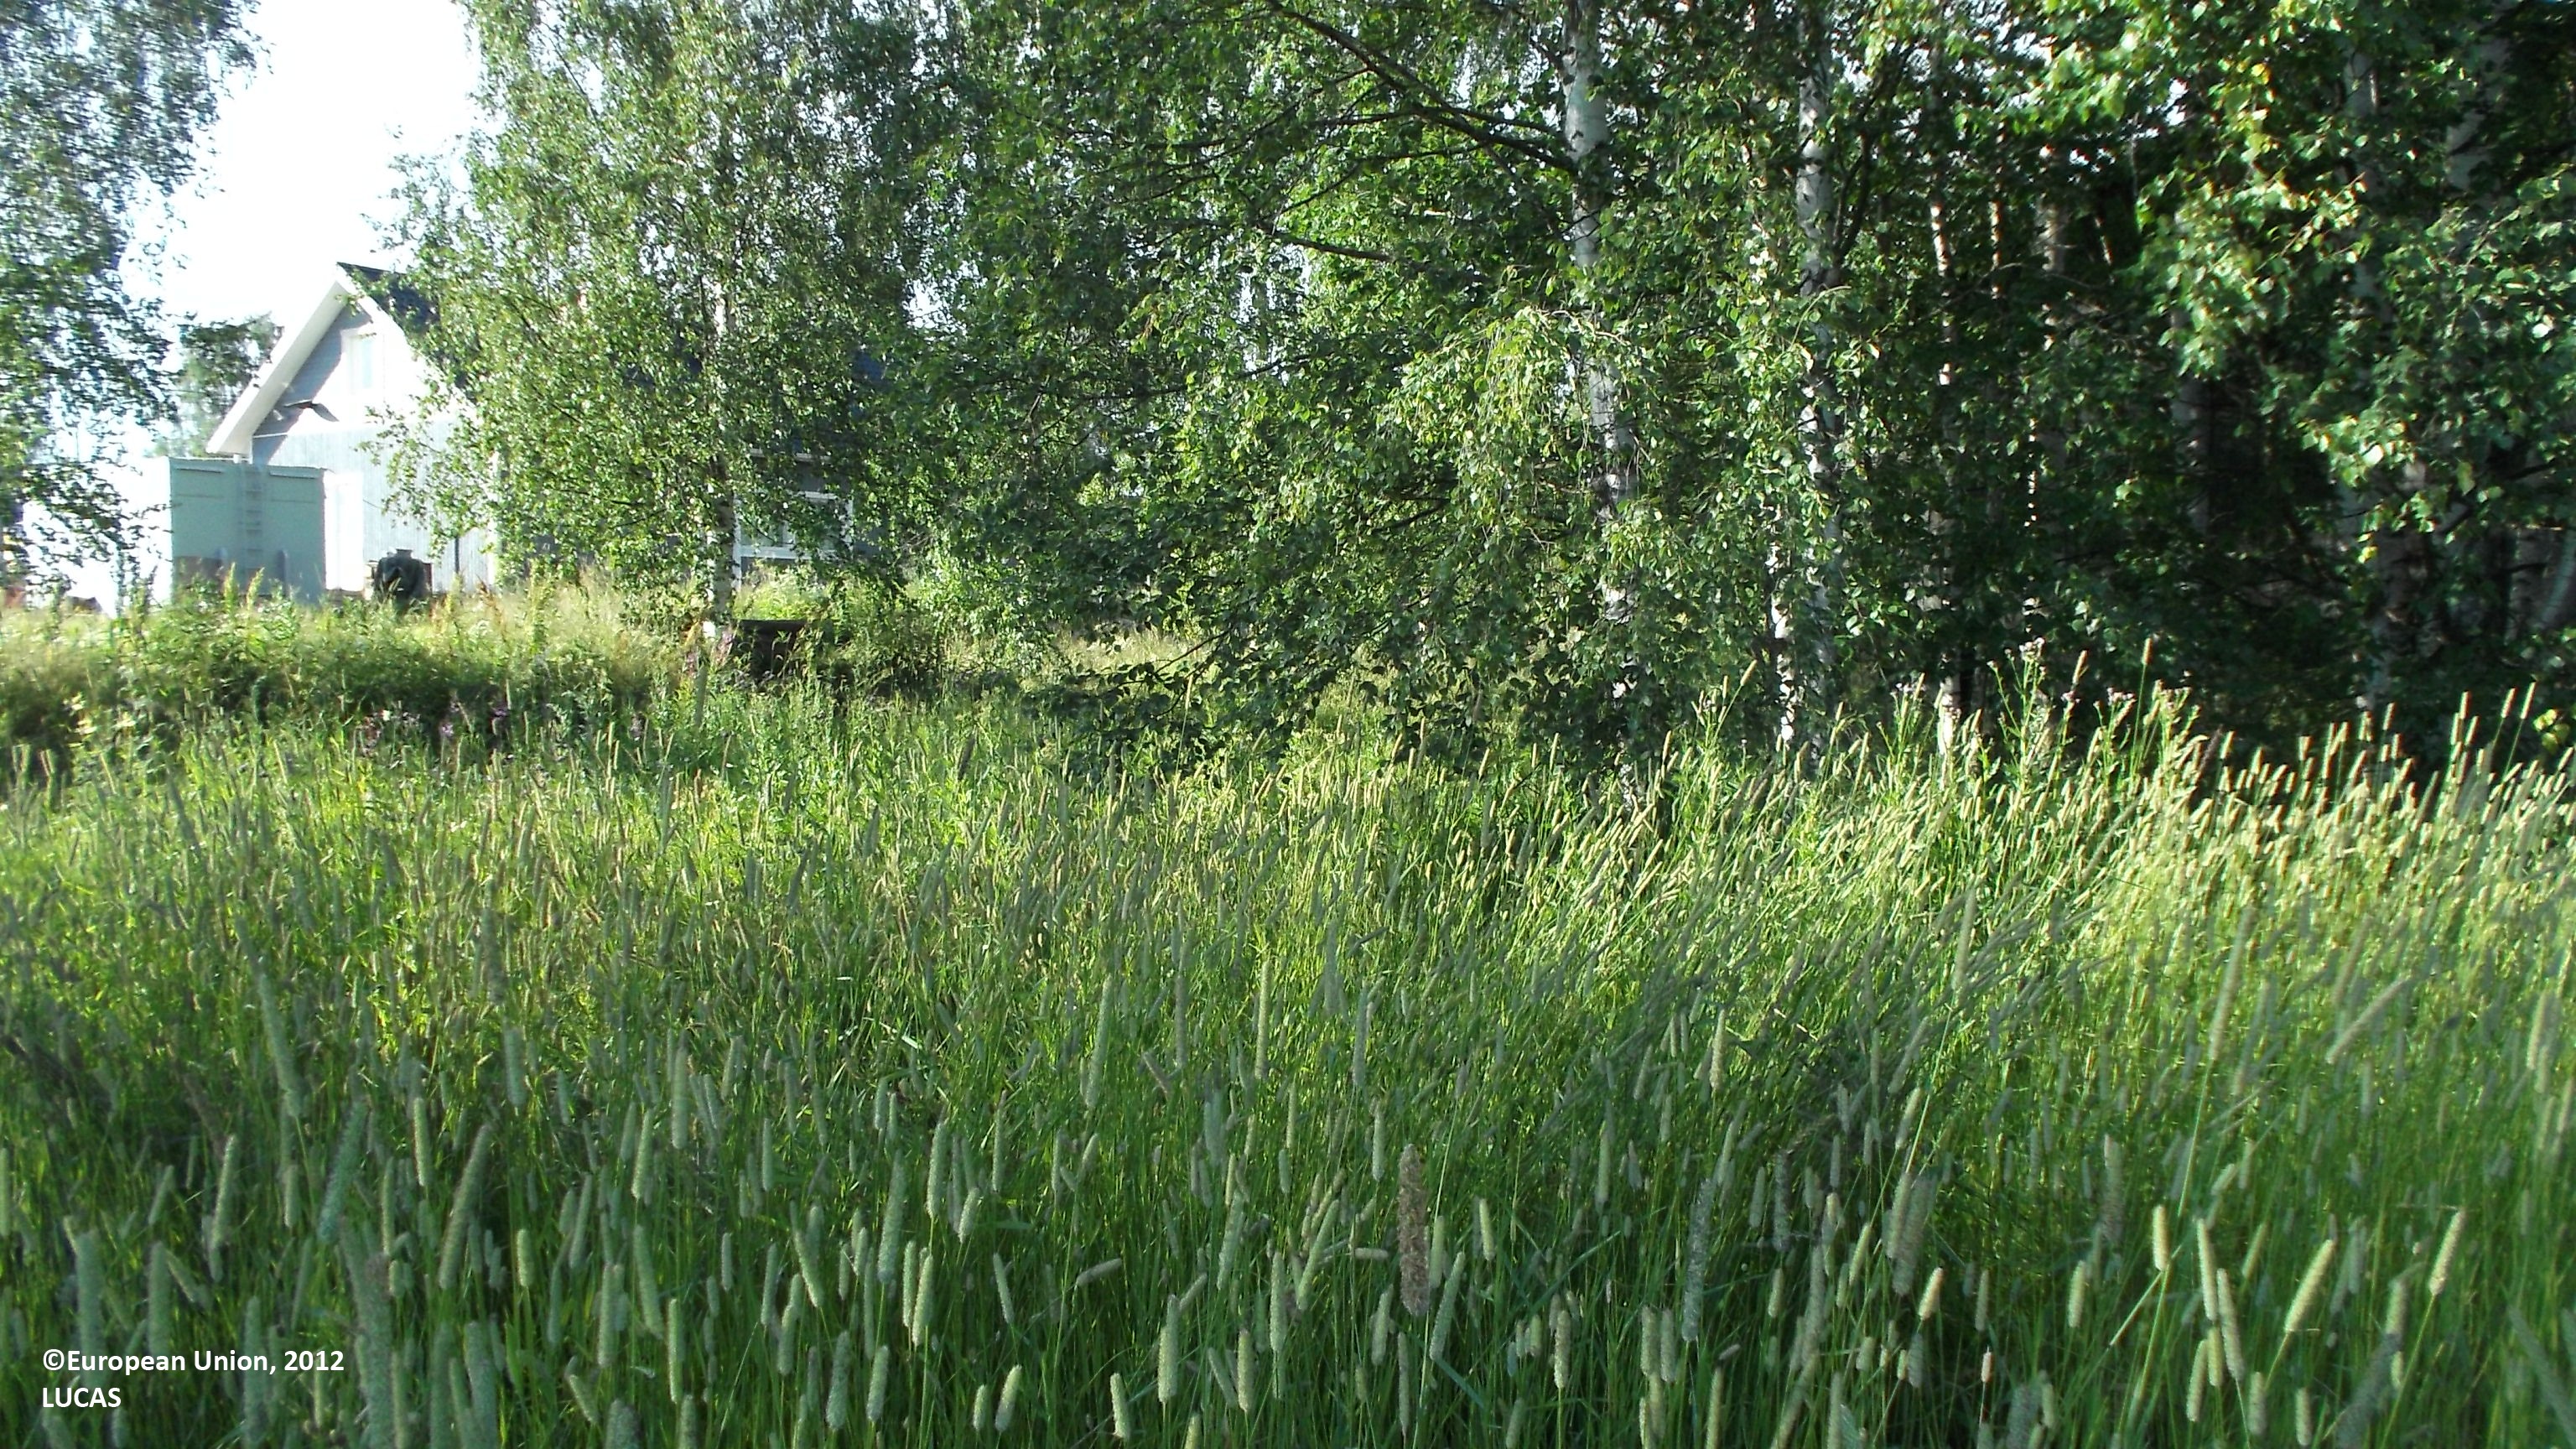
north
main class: Cropland
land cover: Temporary grasslands
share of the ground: 50 - 75 %
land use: Agriculture (excluding fallow land and kitchen gardens)
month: July
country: FI
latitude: 63.2272
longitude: 23.7388
